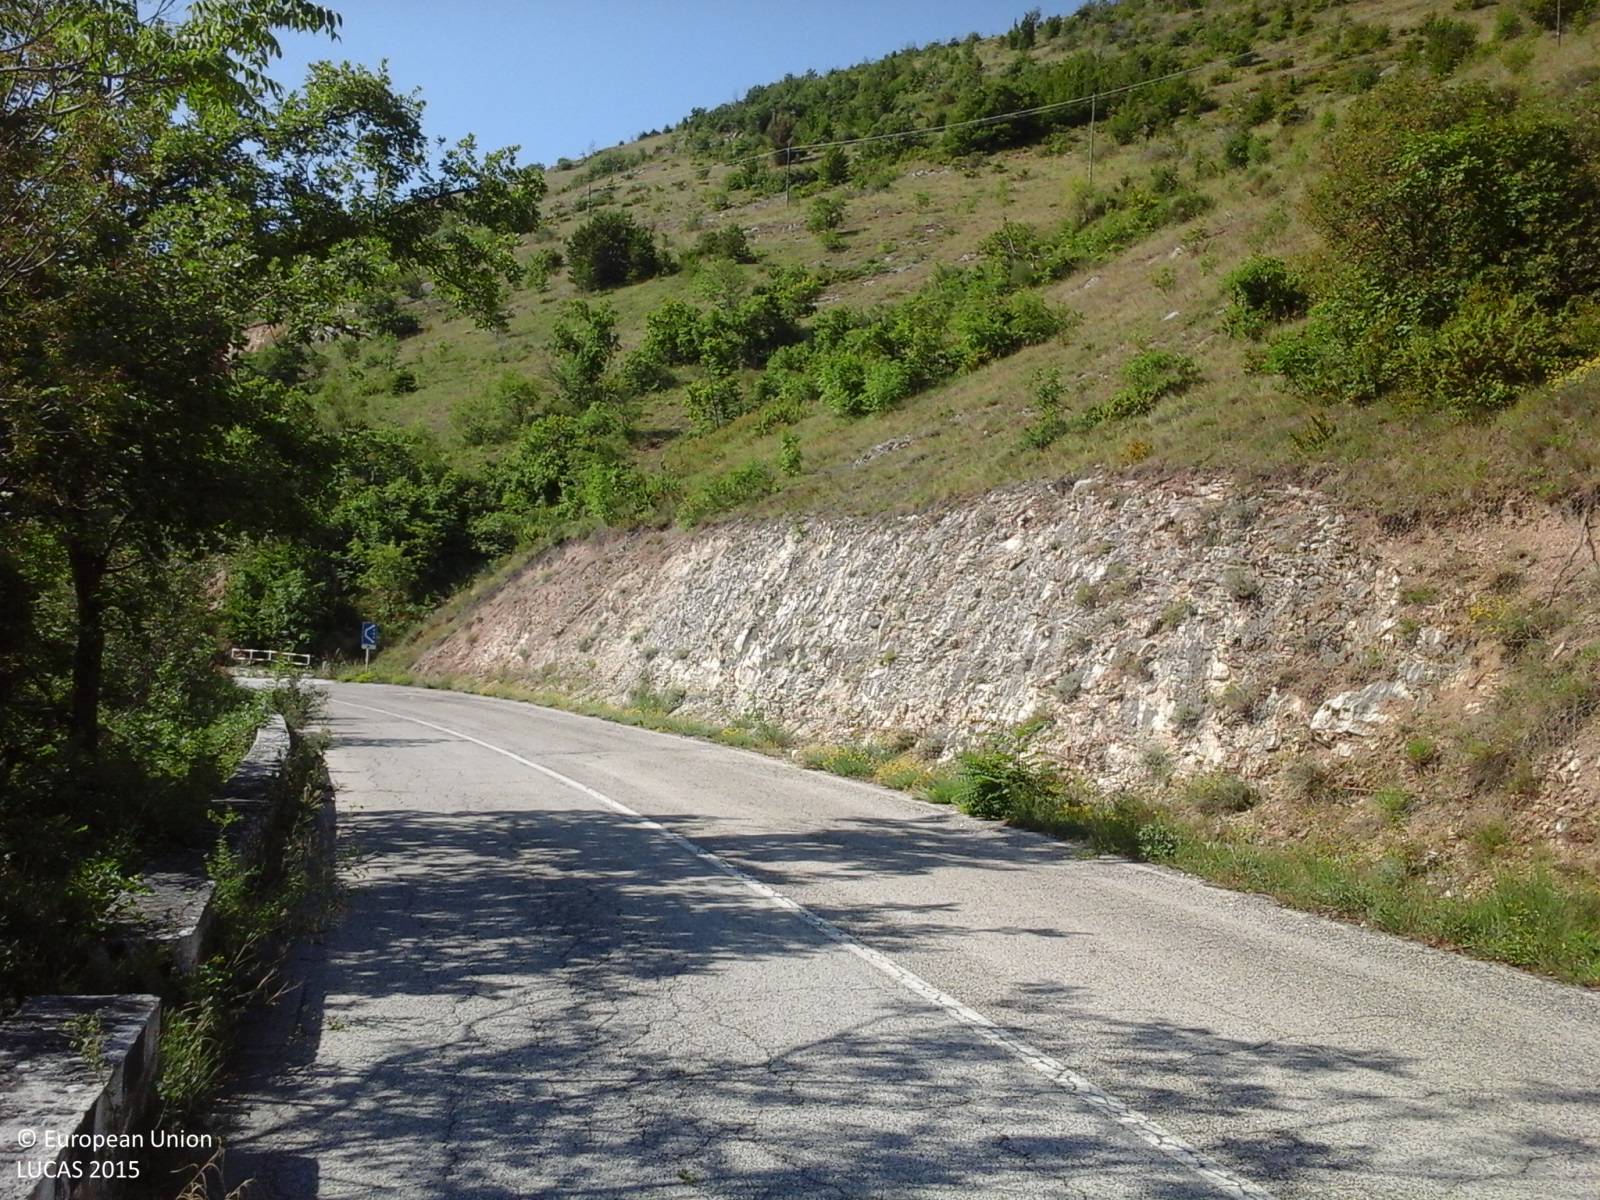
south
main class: Shrubland
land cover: Shrubland with sparse tree cover
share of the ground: > 75 %
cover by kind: herbaceous plants 60 %, shrubs 35 %, broadleaved forest trees 5 %
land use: Semi-natural and natural areas not in use
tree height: < 5 m
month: June
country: IT
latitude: 42.2589
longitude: 13.7579
